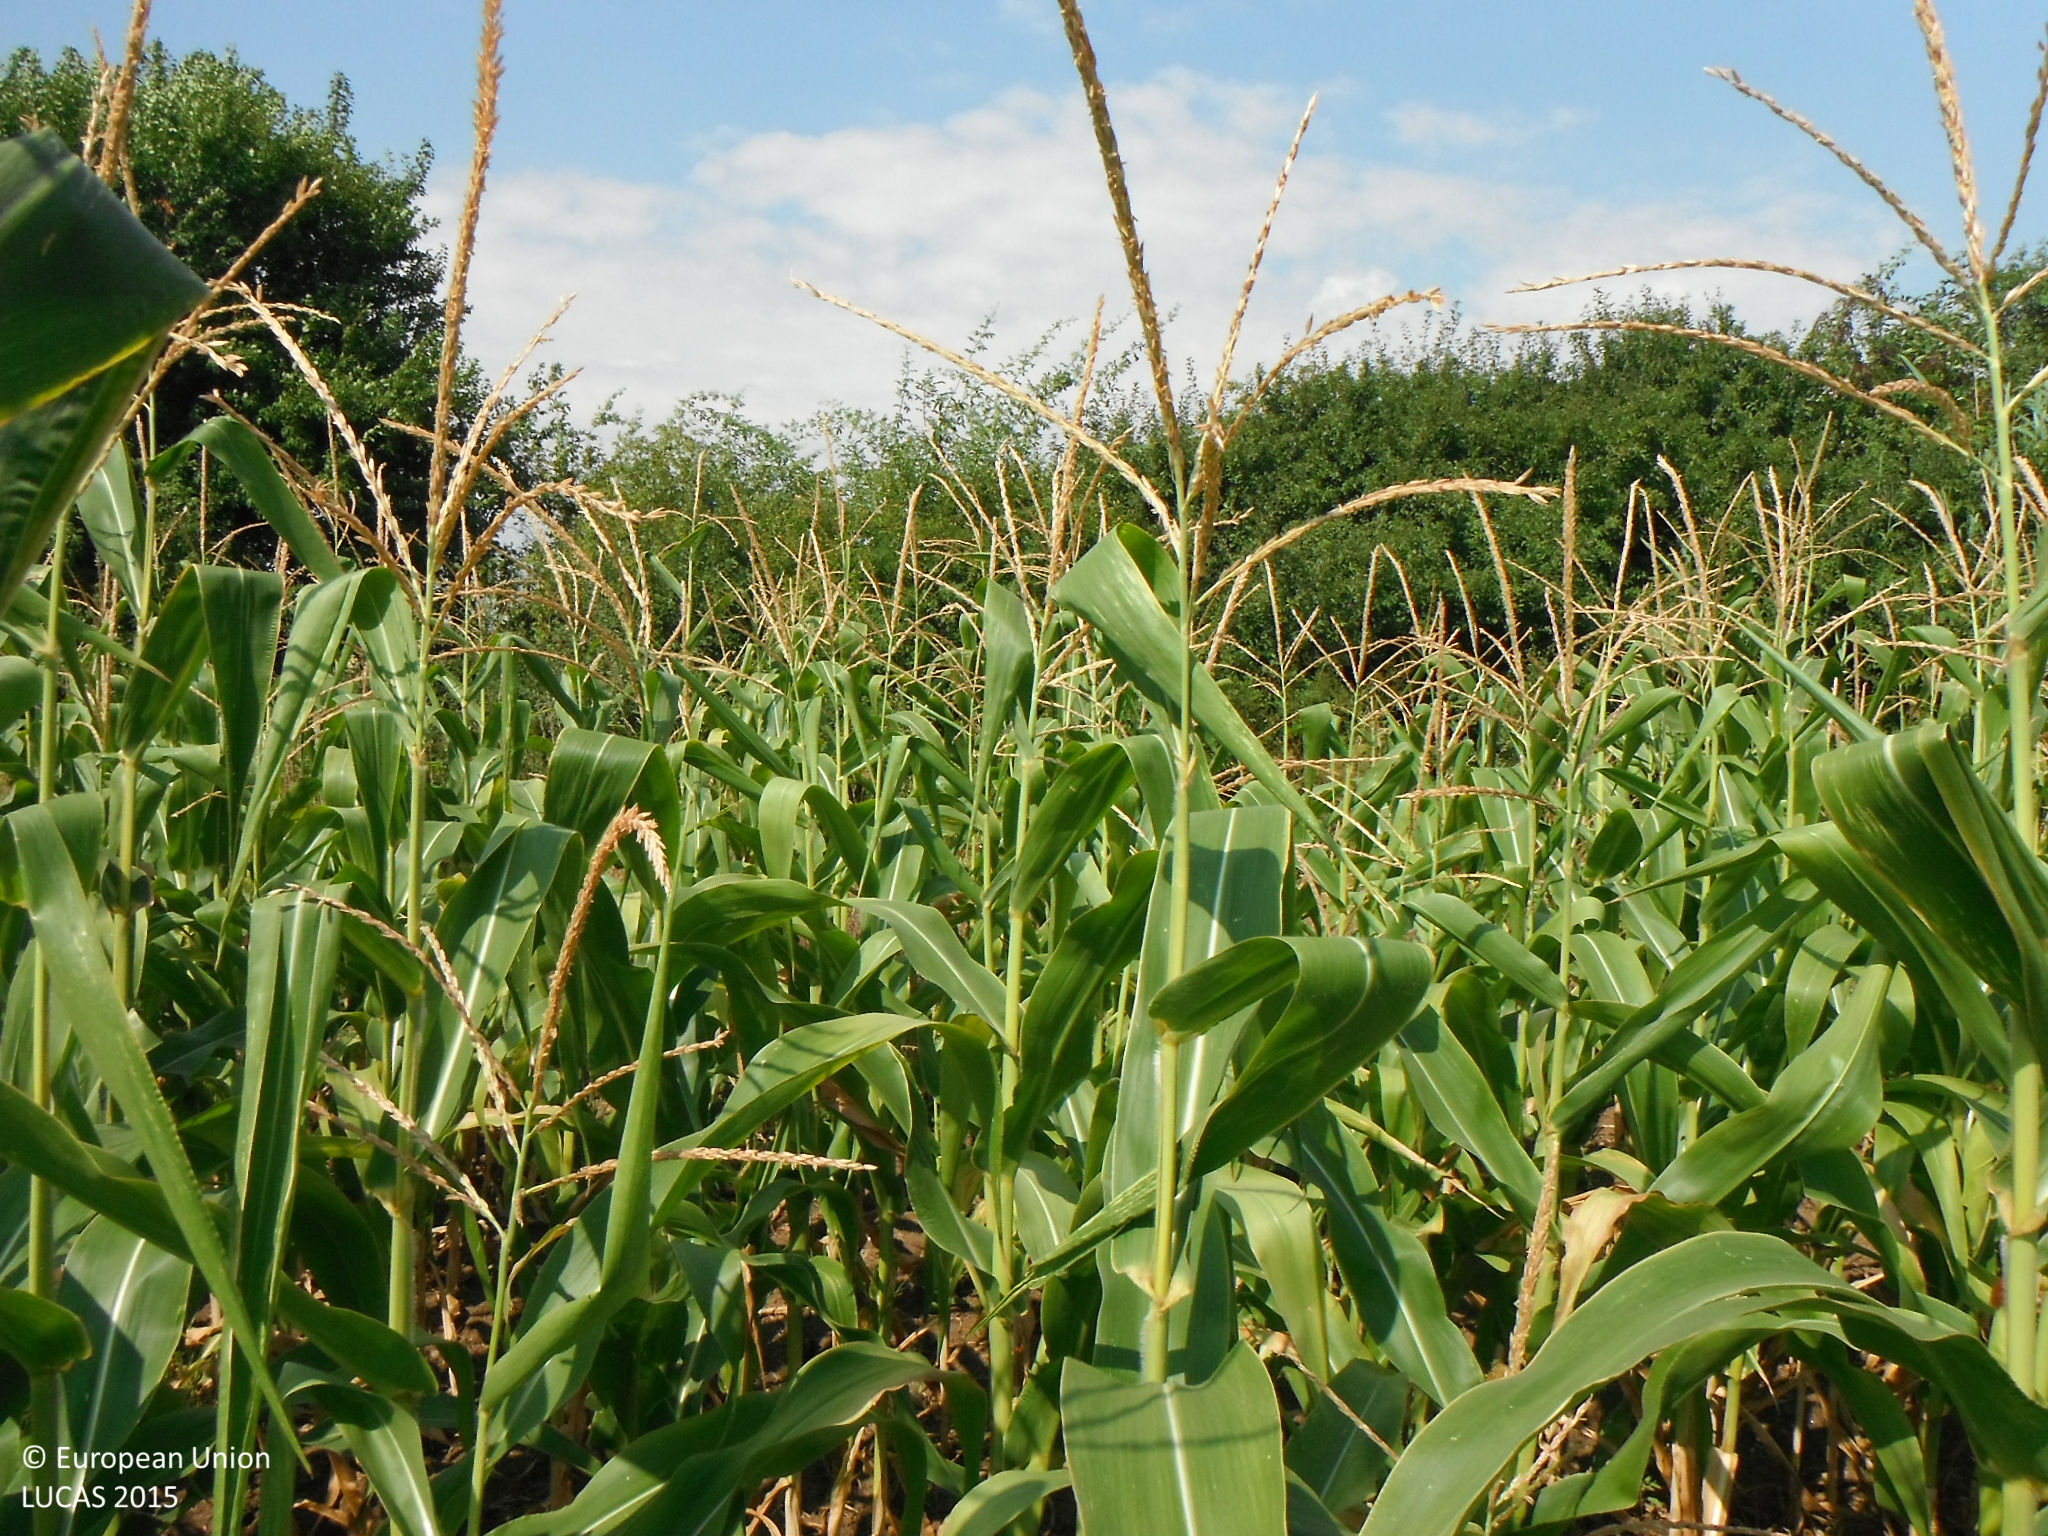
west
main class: Cropland
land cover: Maize
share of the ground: > 75 %
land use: Agriculture (excluding fallow land and kitchen gardens)
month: August
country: SK
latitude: 48.1516
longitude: 18.6873
